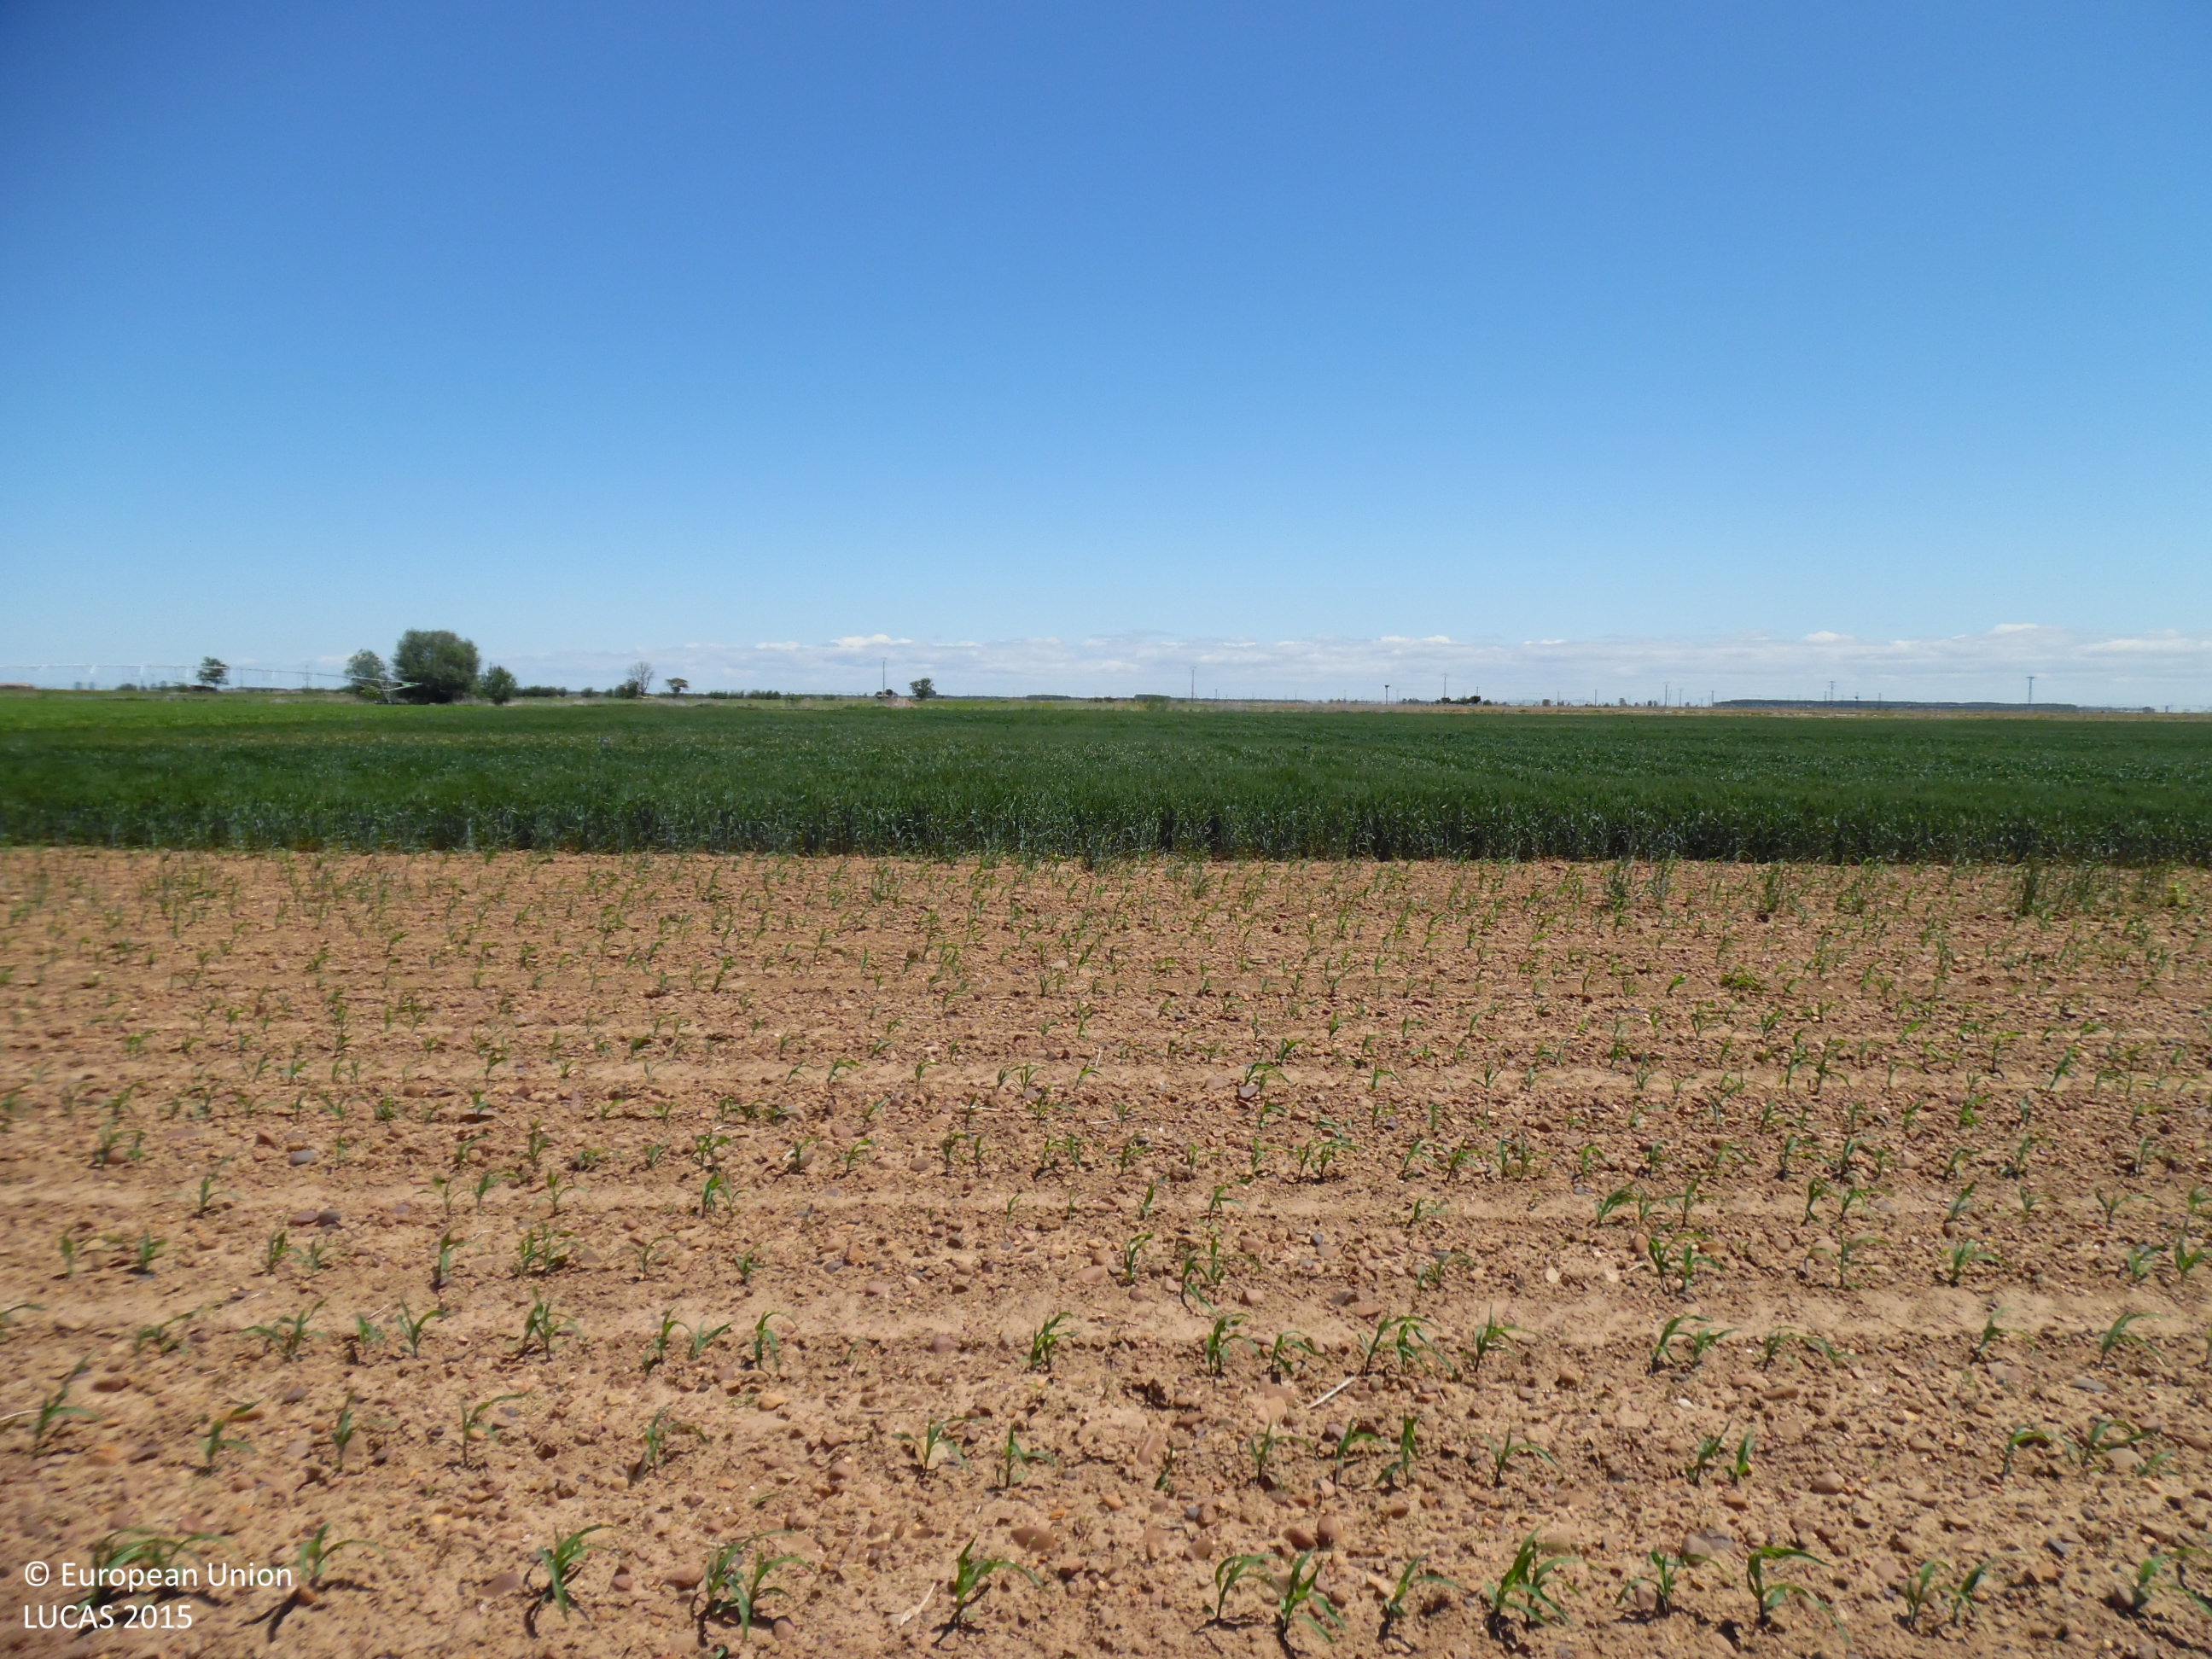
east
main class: Cropland
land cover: Maize
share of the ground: > 75 %
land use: Agriculture (excluding fallow land and kitchen gardens)
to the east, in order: Maize; Durum wheat; Grass margins; Ditches and canals; Grass margins; Maize
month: May
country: ES
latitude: 42.2796
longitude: -5.7269
